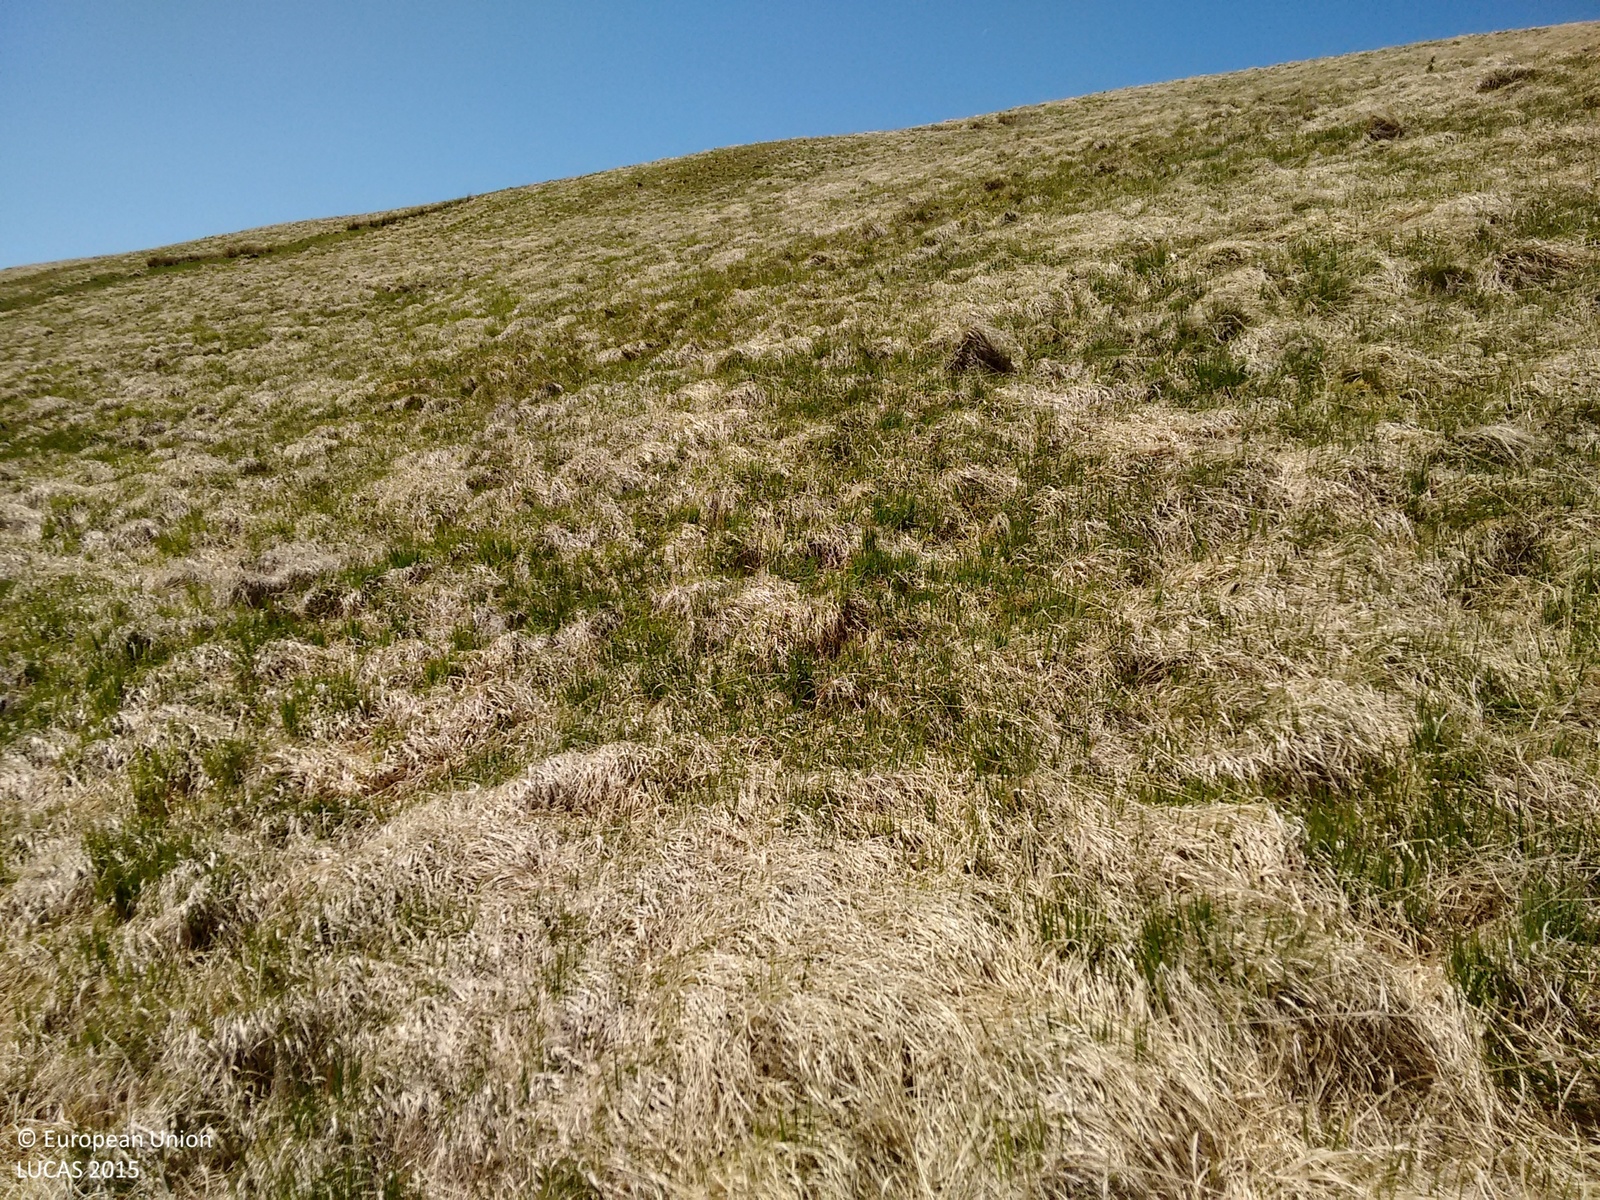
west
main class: Grassland
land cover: Grassland without tree/shrub cover
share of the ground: > 75 %
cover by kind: herbaceous plants 100 %
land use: Semi-natural and natural areas not in use
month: June
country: GB
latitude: 55.4723
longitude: -3.4779
